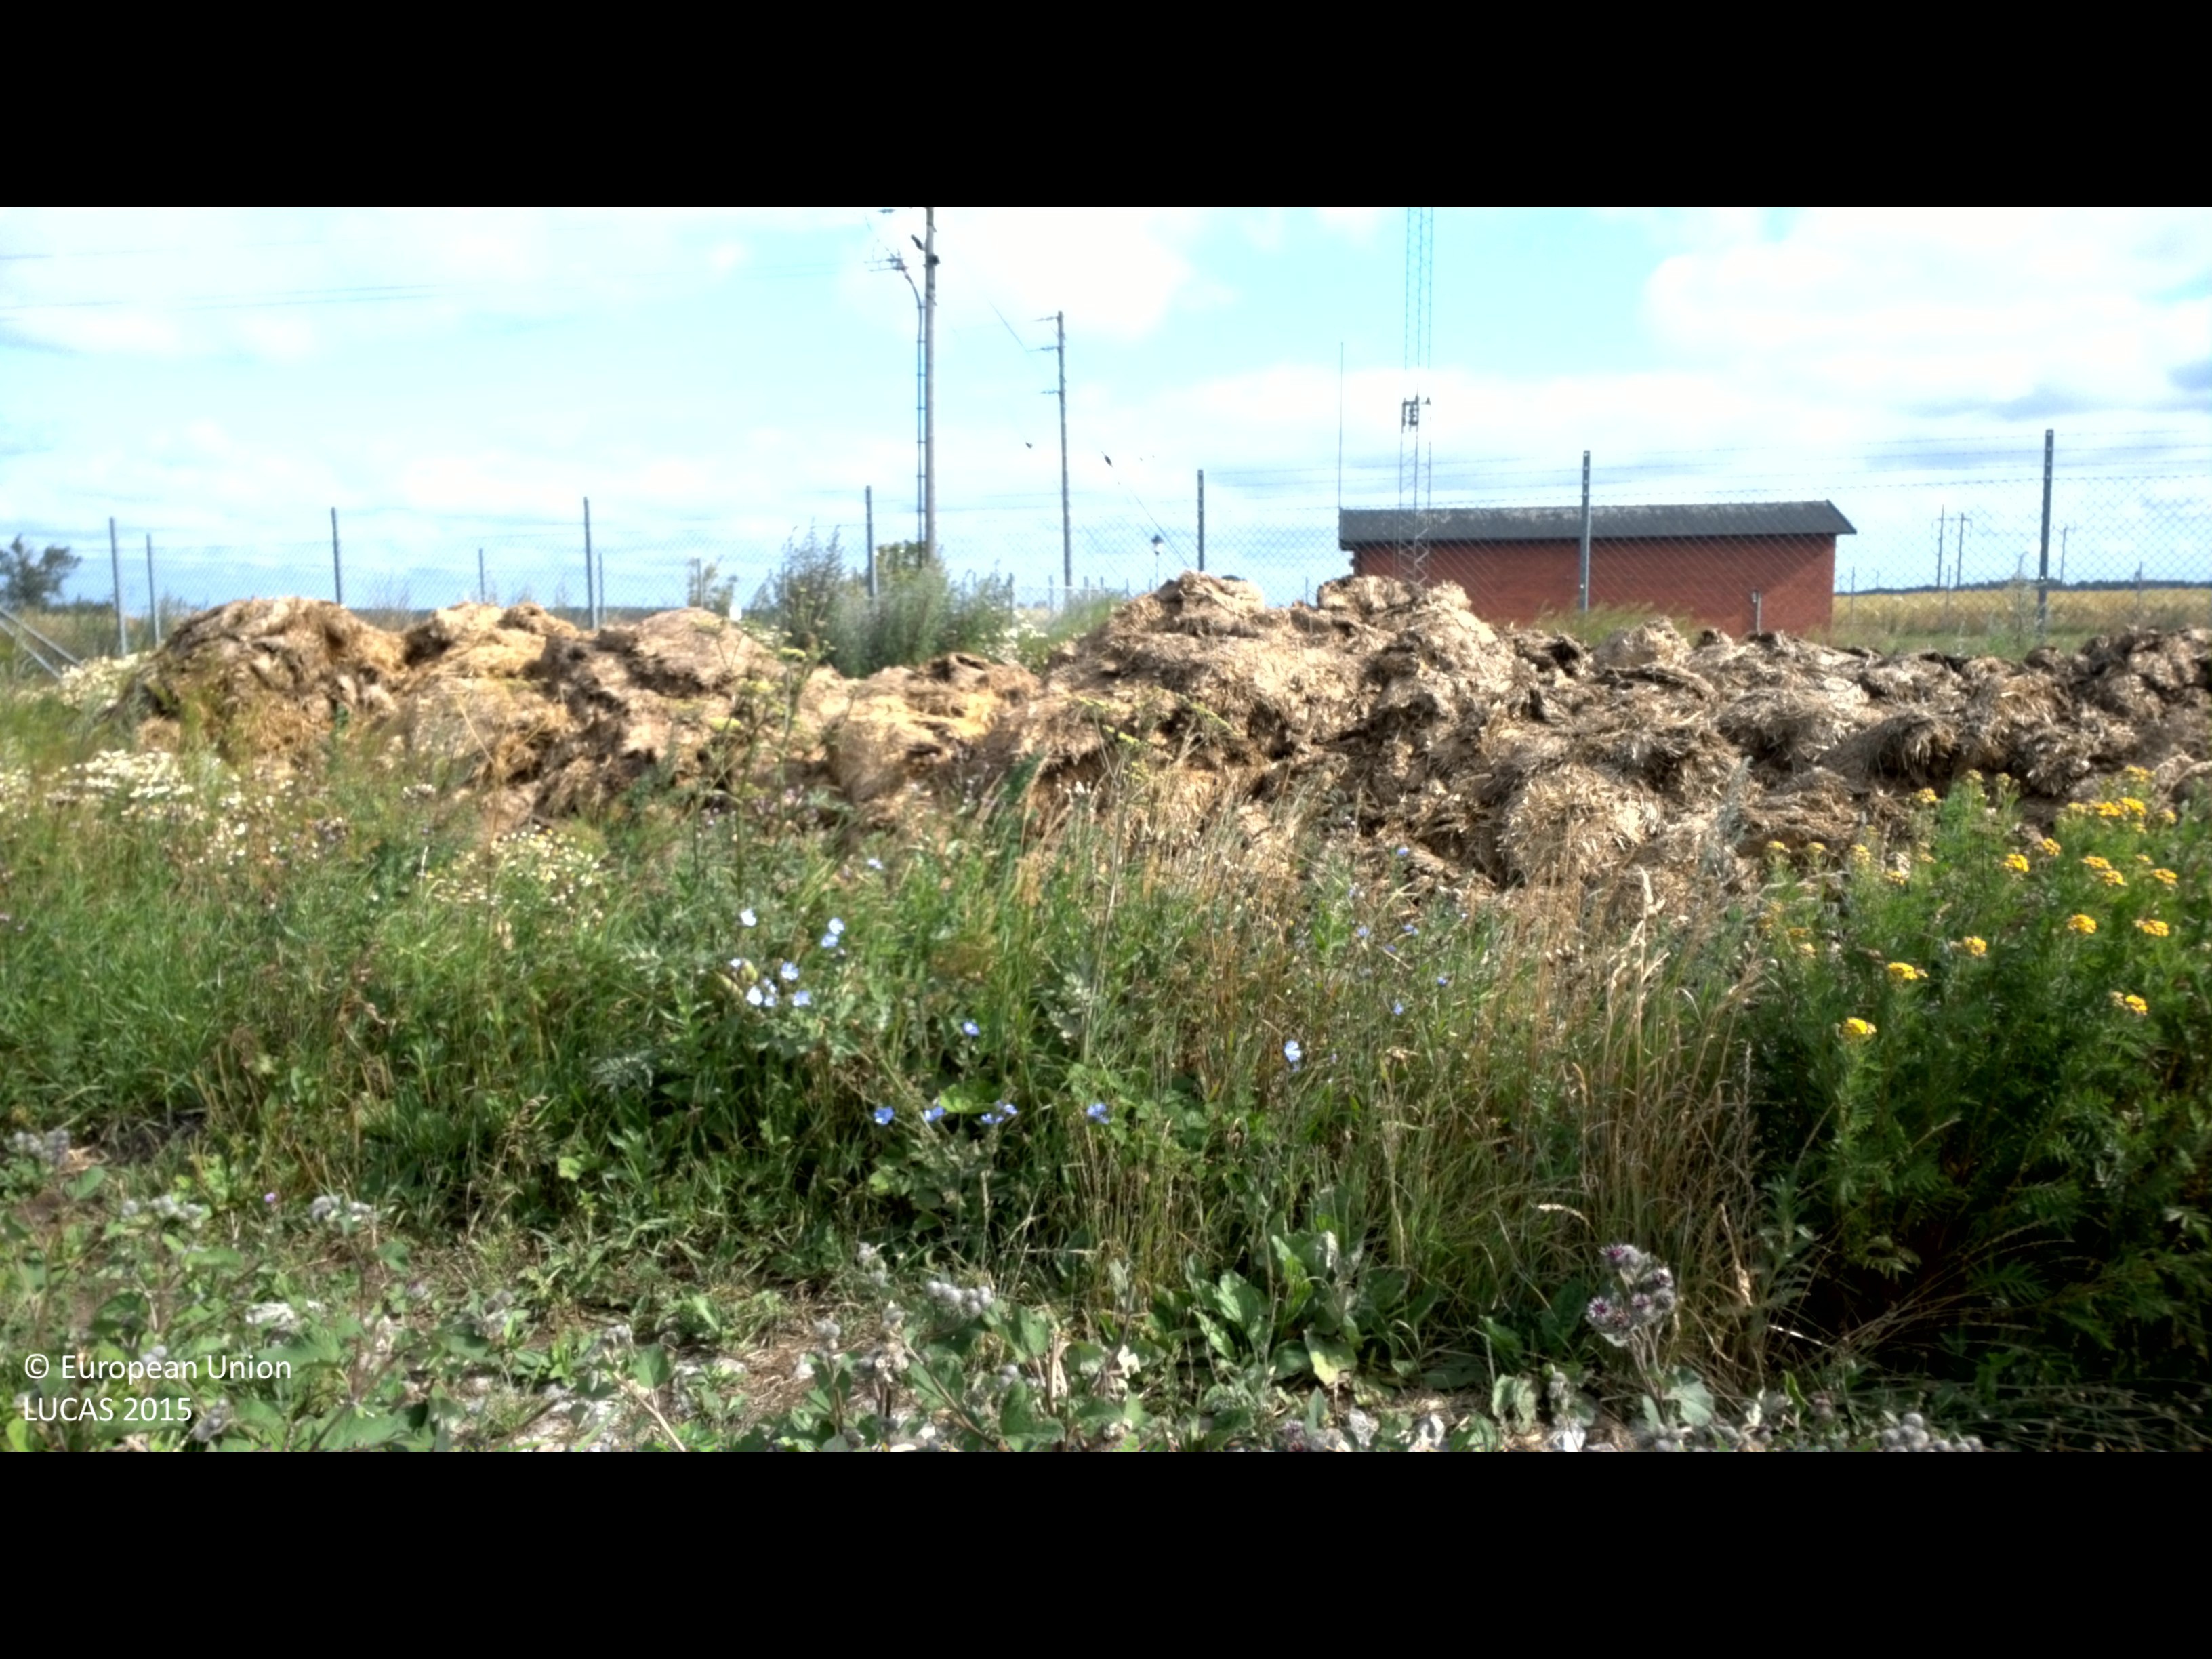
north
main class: Cropland
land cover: Dry pulses
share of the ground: > 75 %
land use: Agriculture (excluding fallow land and kitchen gardens)
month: July
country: SE
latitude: 56.5141
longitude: 16.4208
